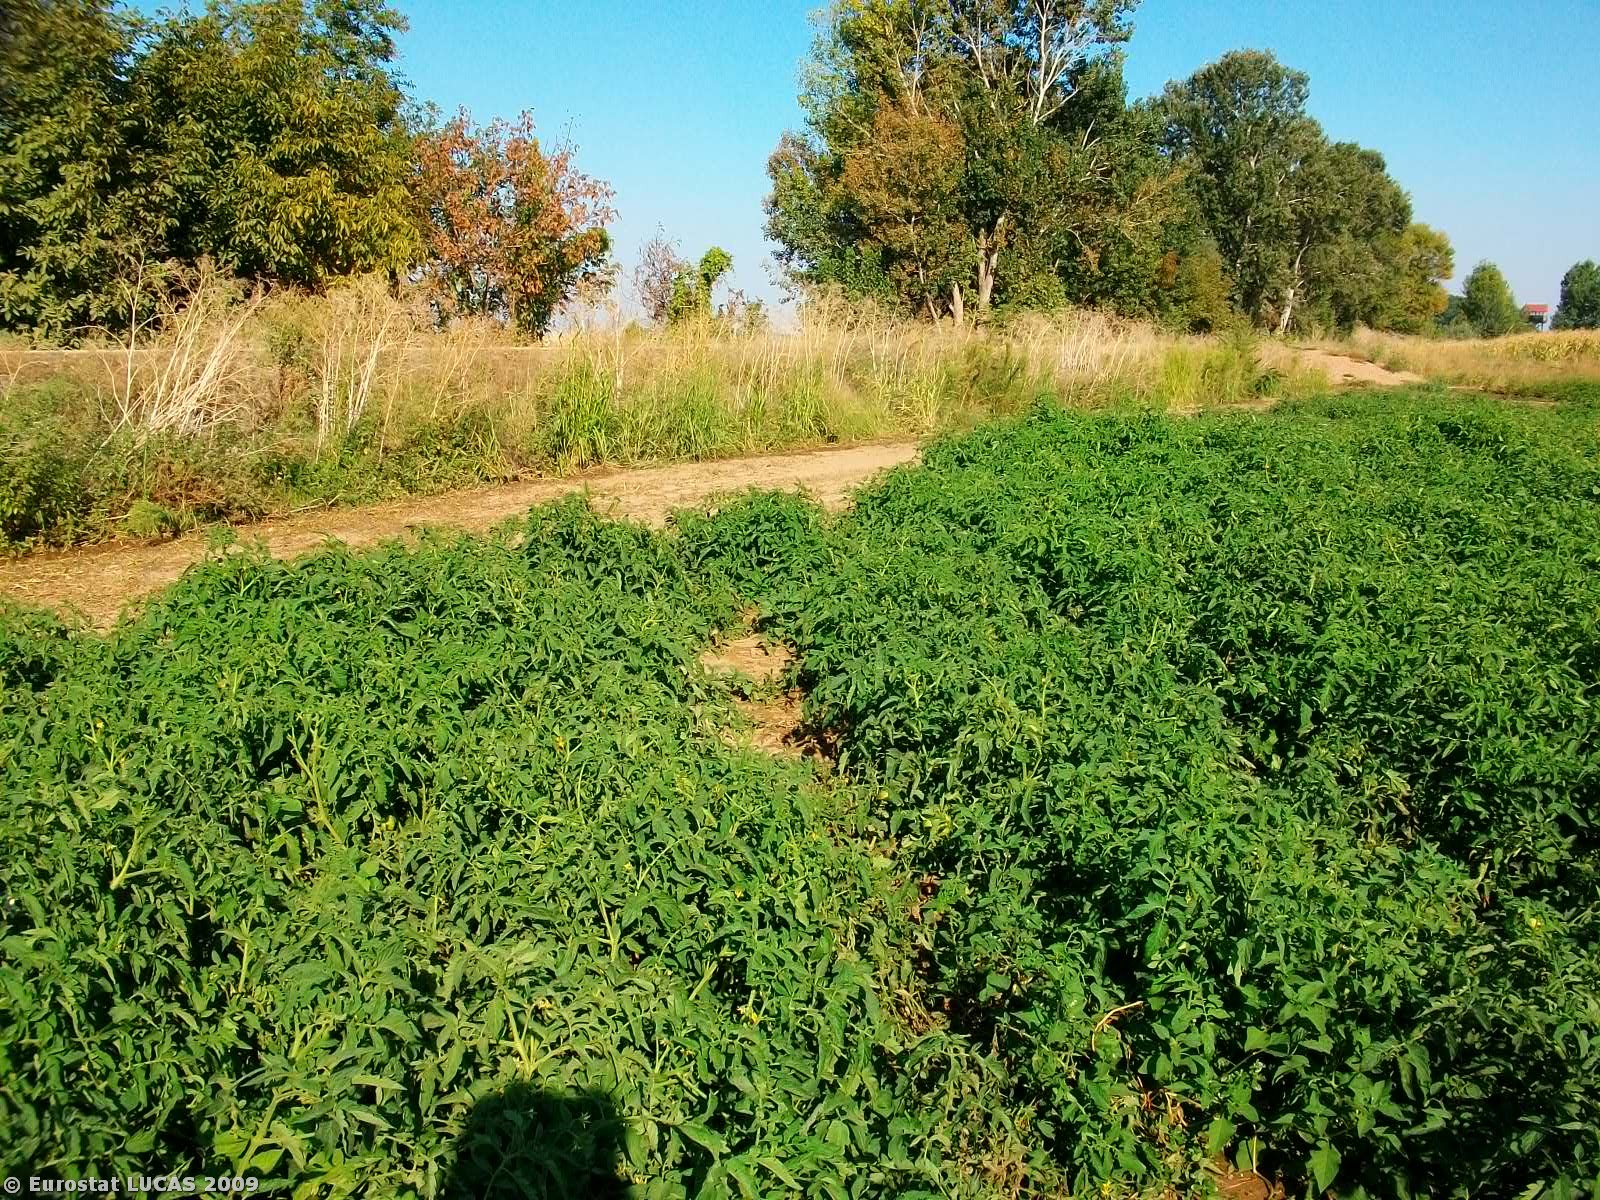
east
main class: Cropland
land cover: Tomatoes
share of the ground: > 75 %
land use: Agriculture (excluding fallow land and kitchen gardens)
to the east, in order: Tomatoes; Grass margins; Paved roads, cycling and walking lanes; Abandoned hedges; Ditches and canals; Abandoned hedges; Shruby margins; Tracks; Sugar beet
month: September
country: GR
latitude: 41.6113
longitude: 26.5577
